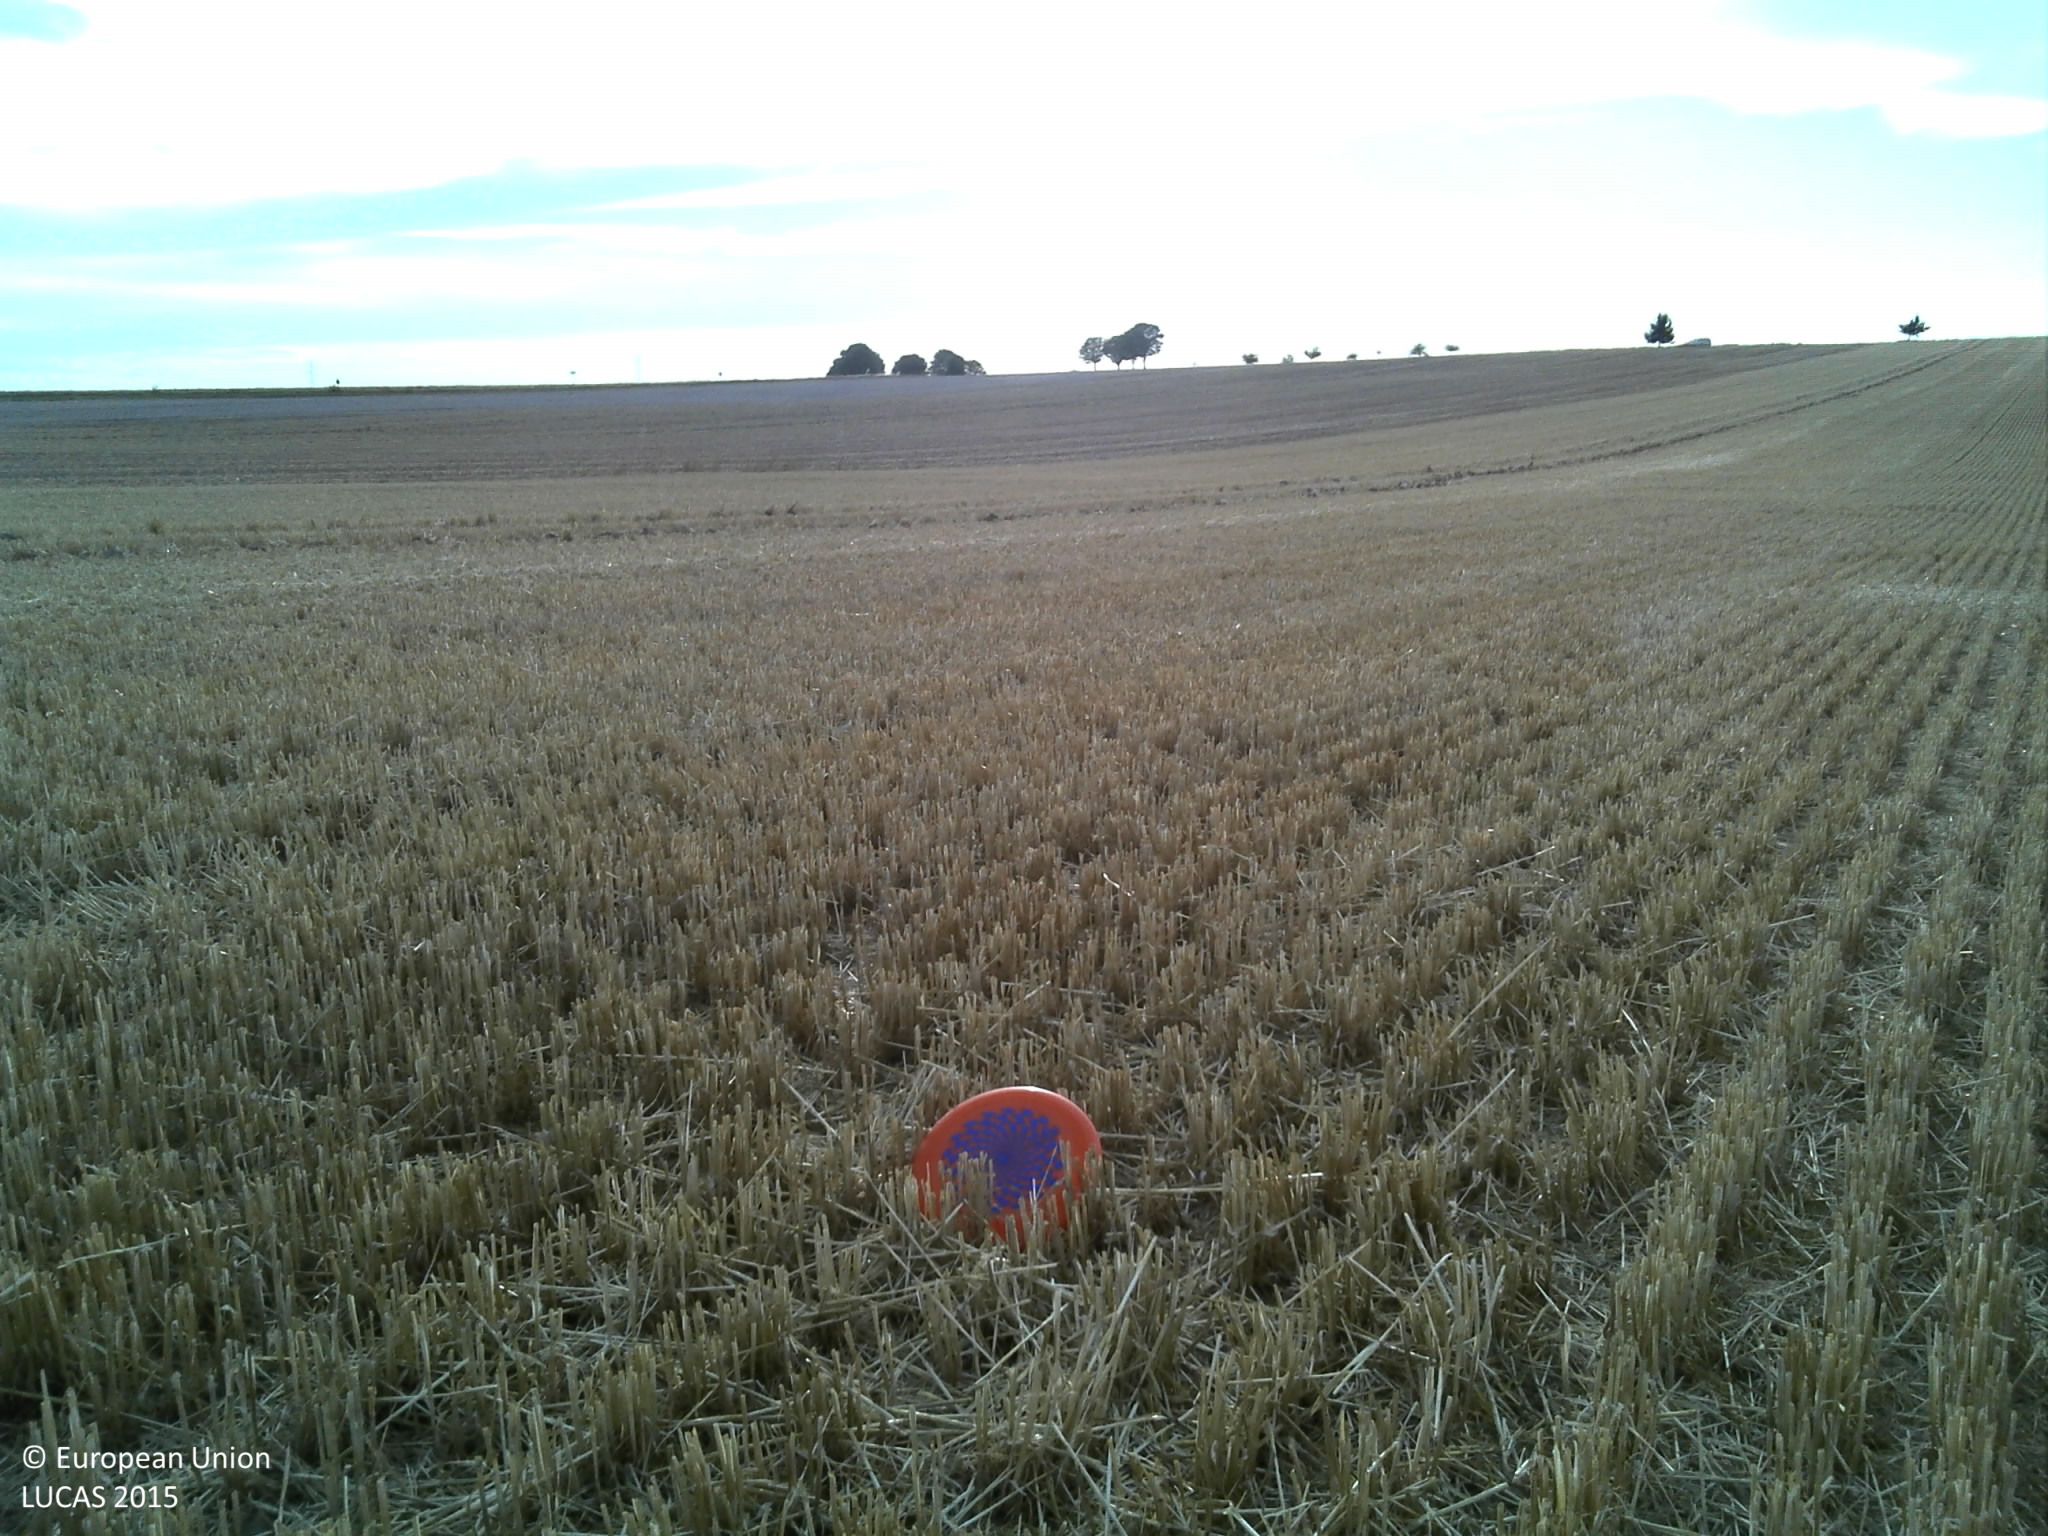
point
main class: Cropland
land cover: Barley
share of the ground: > 75 %
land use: Agriculture (excluding fallow land and kitchen gardens)
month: August
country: FR
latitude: 48.9454
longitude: 4.7406
